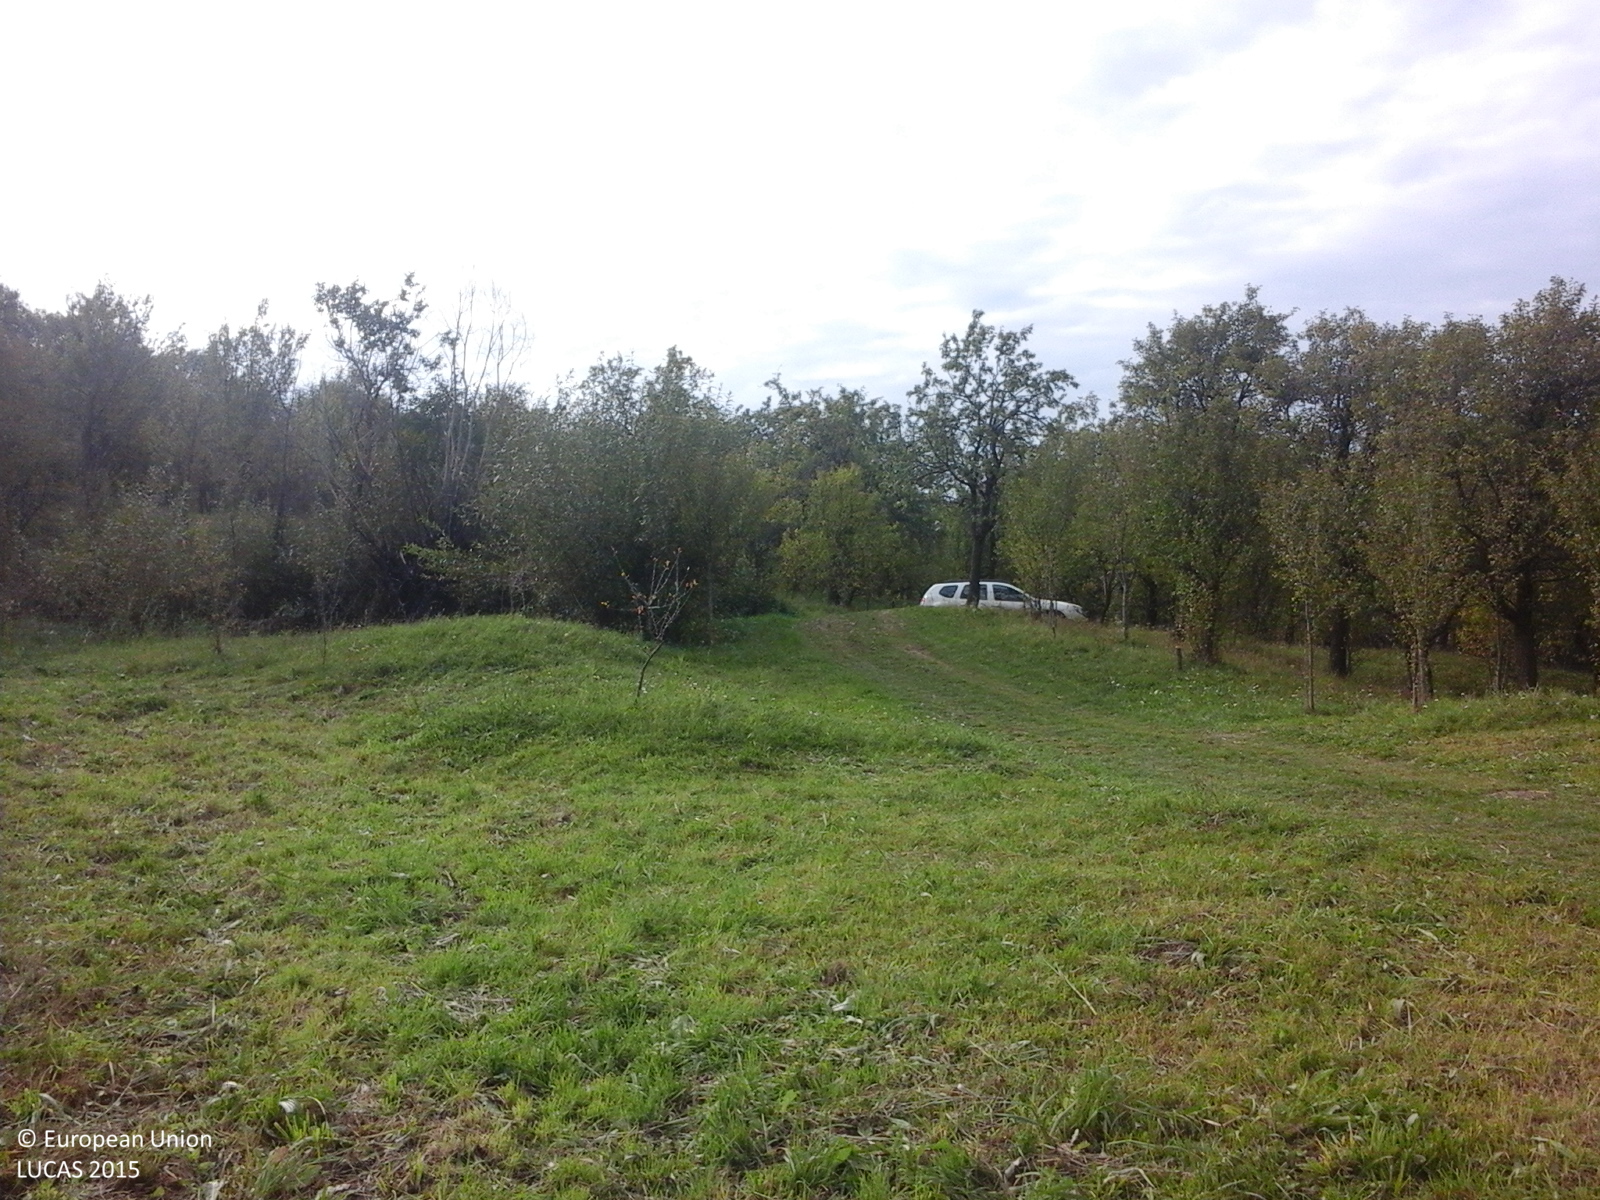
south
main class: Grassland
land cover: Grassland without tree/shrub cover
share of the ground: > 75 %
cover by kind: herbaceous plants 100 %
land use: Agriculture (excluding fallow land and kitchen gardens)
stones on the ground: < 10 %
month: October
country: RO
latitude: 46.3741
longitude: 25.3272
